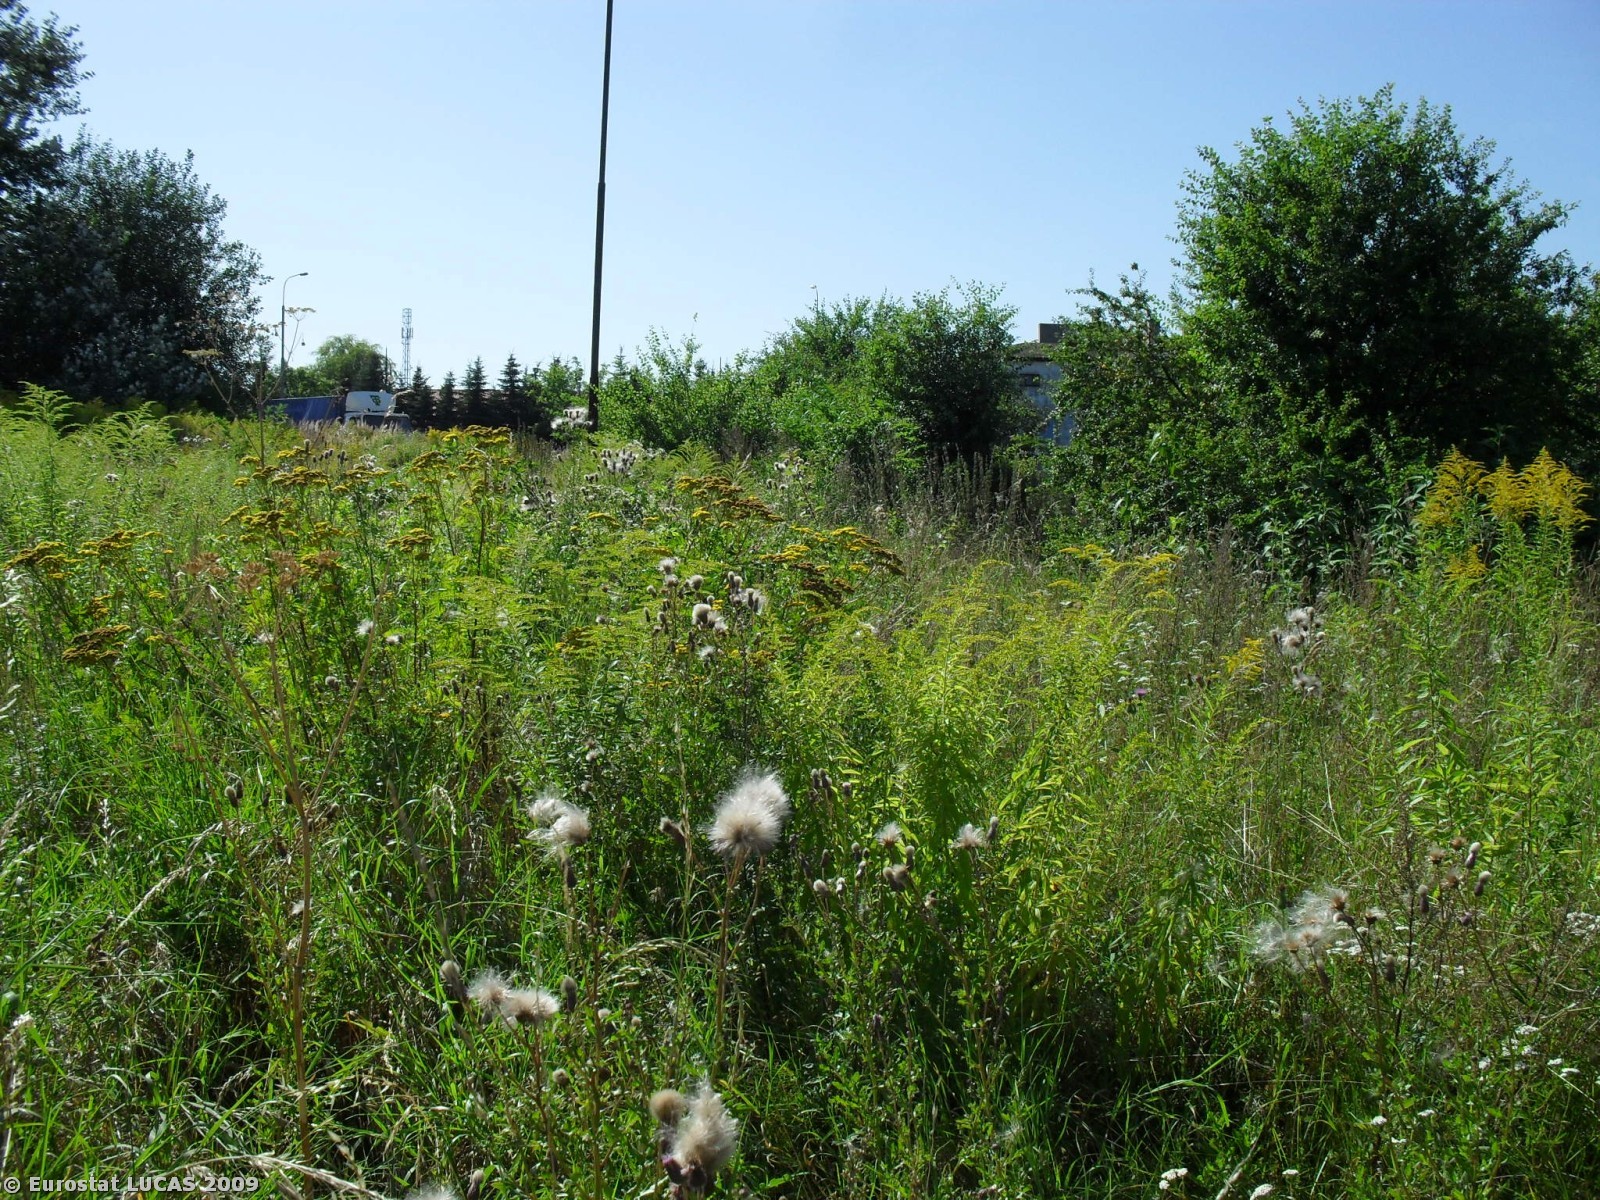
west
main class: Grassland
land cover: Spontaneously vegetated surfaces
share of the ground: > 75 %
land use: Unused
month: August
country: PL
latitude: 51.6521
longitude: 19.4950
